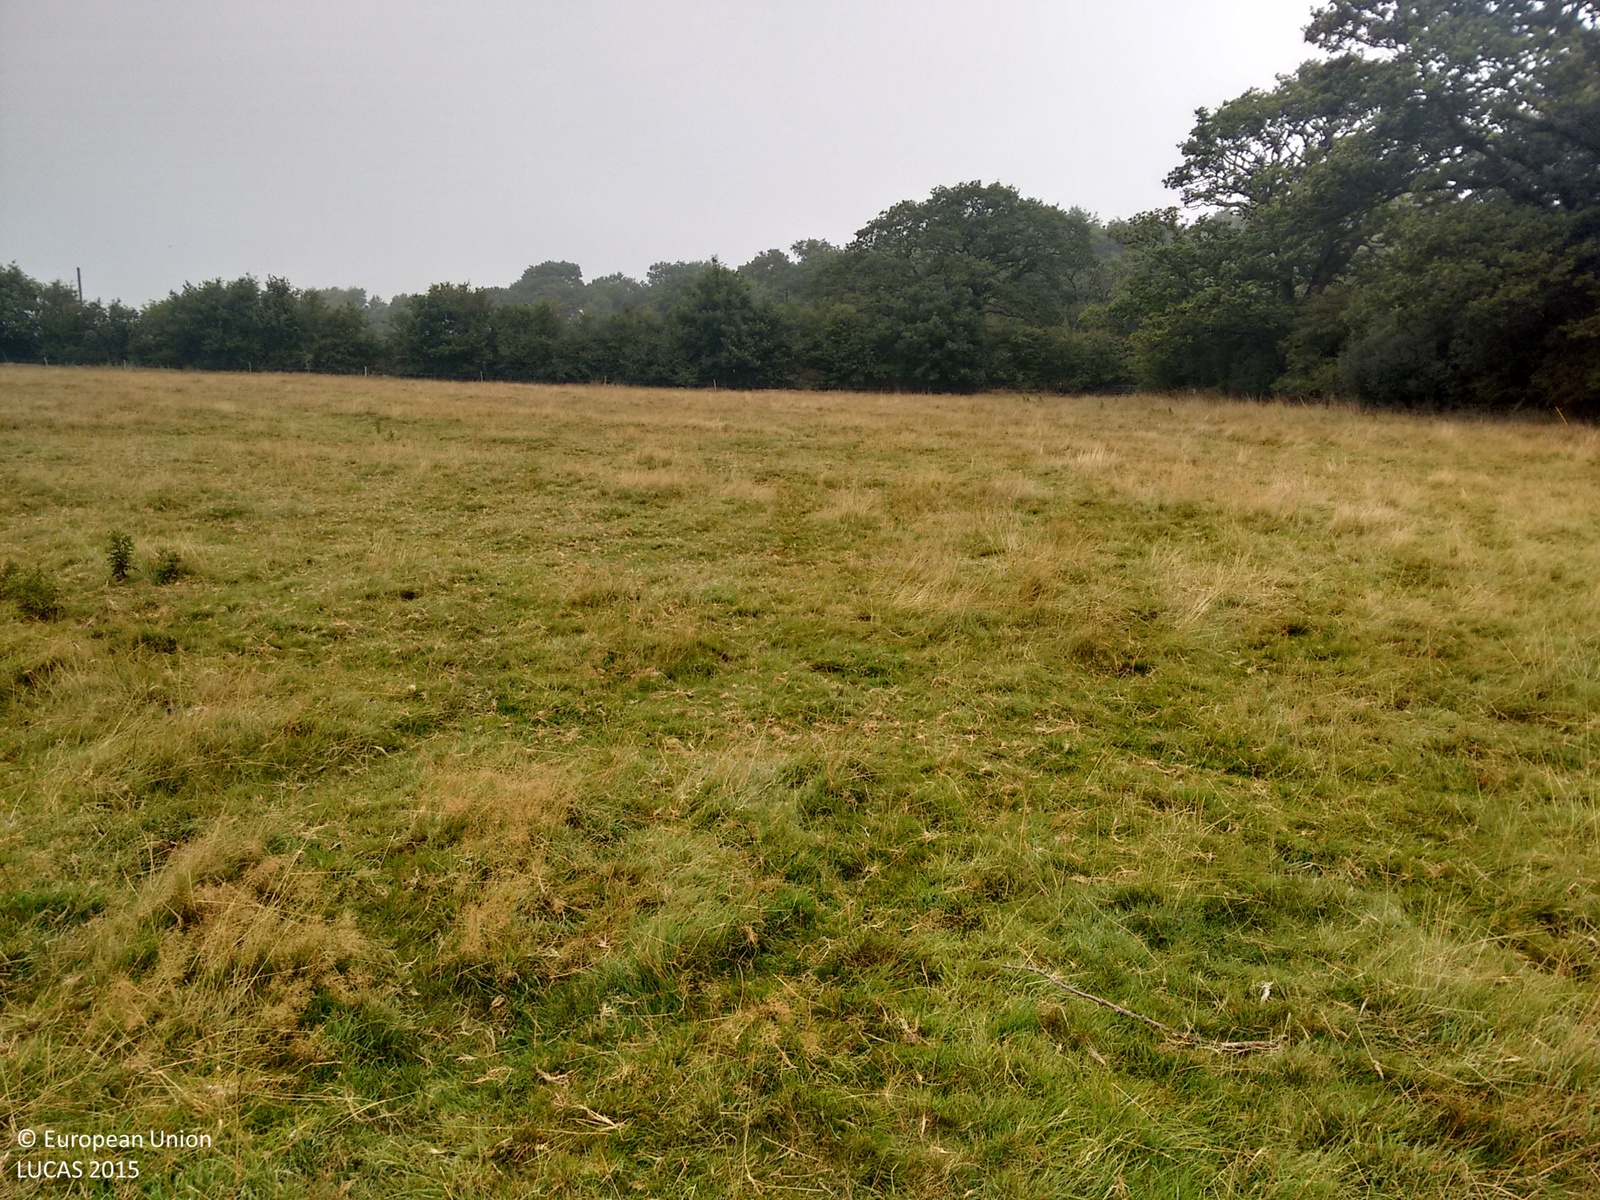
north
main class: Grassland
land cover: Grassland without tree/shrub cover
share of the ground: > 75 %
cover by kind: herbaceous plants 100 %
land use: Agriculture (excluding fallow land and kitchen gardens)
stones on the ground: < 10 %
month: September
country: GB
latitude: 52.6257
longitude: -2.8208
